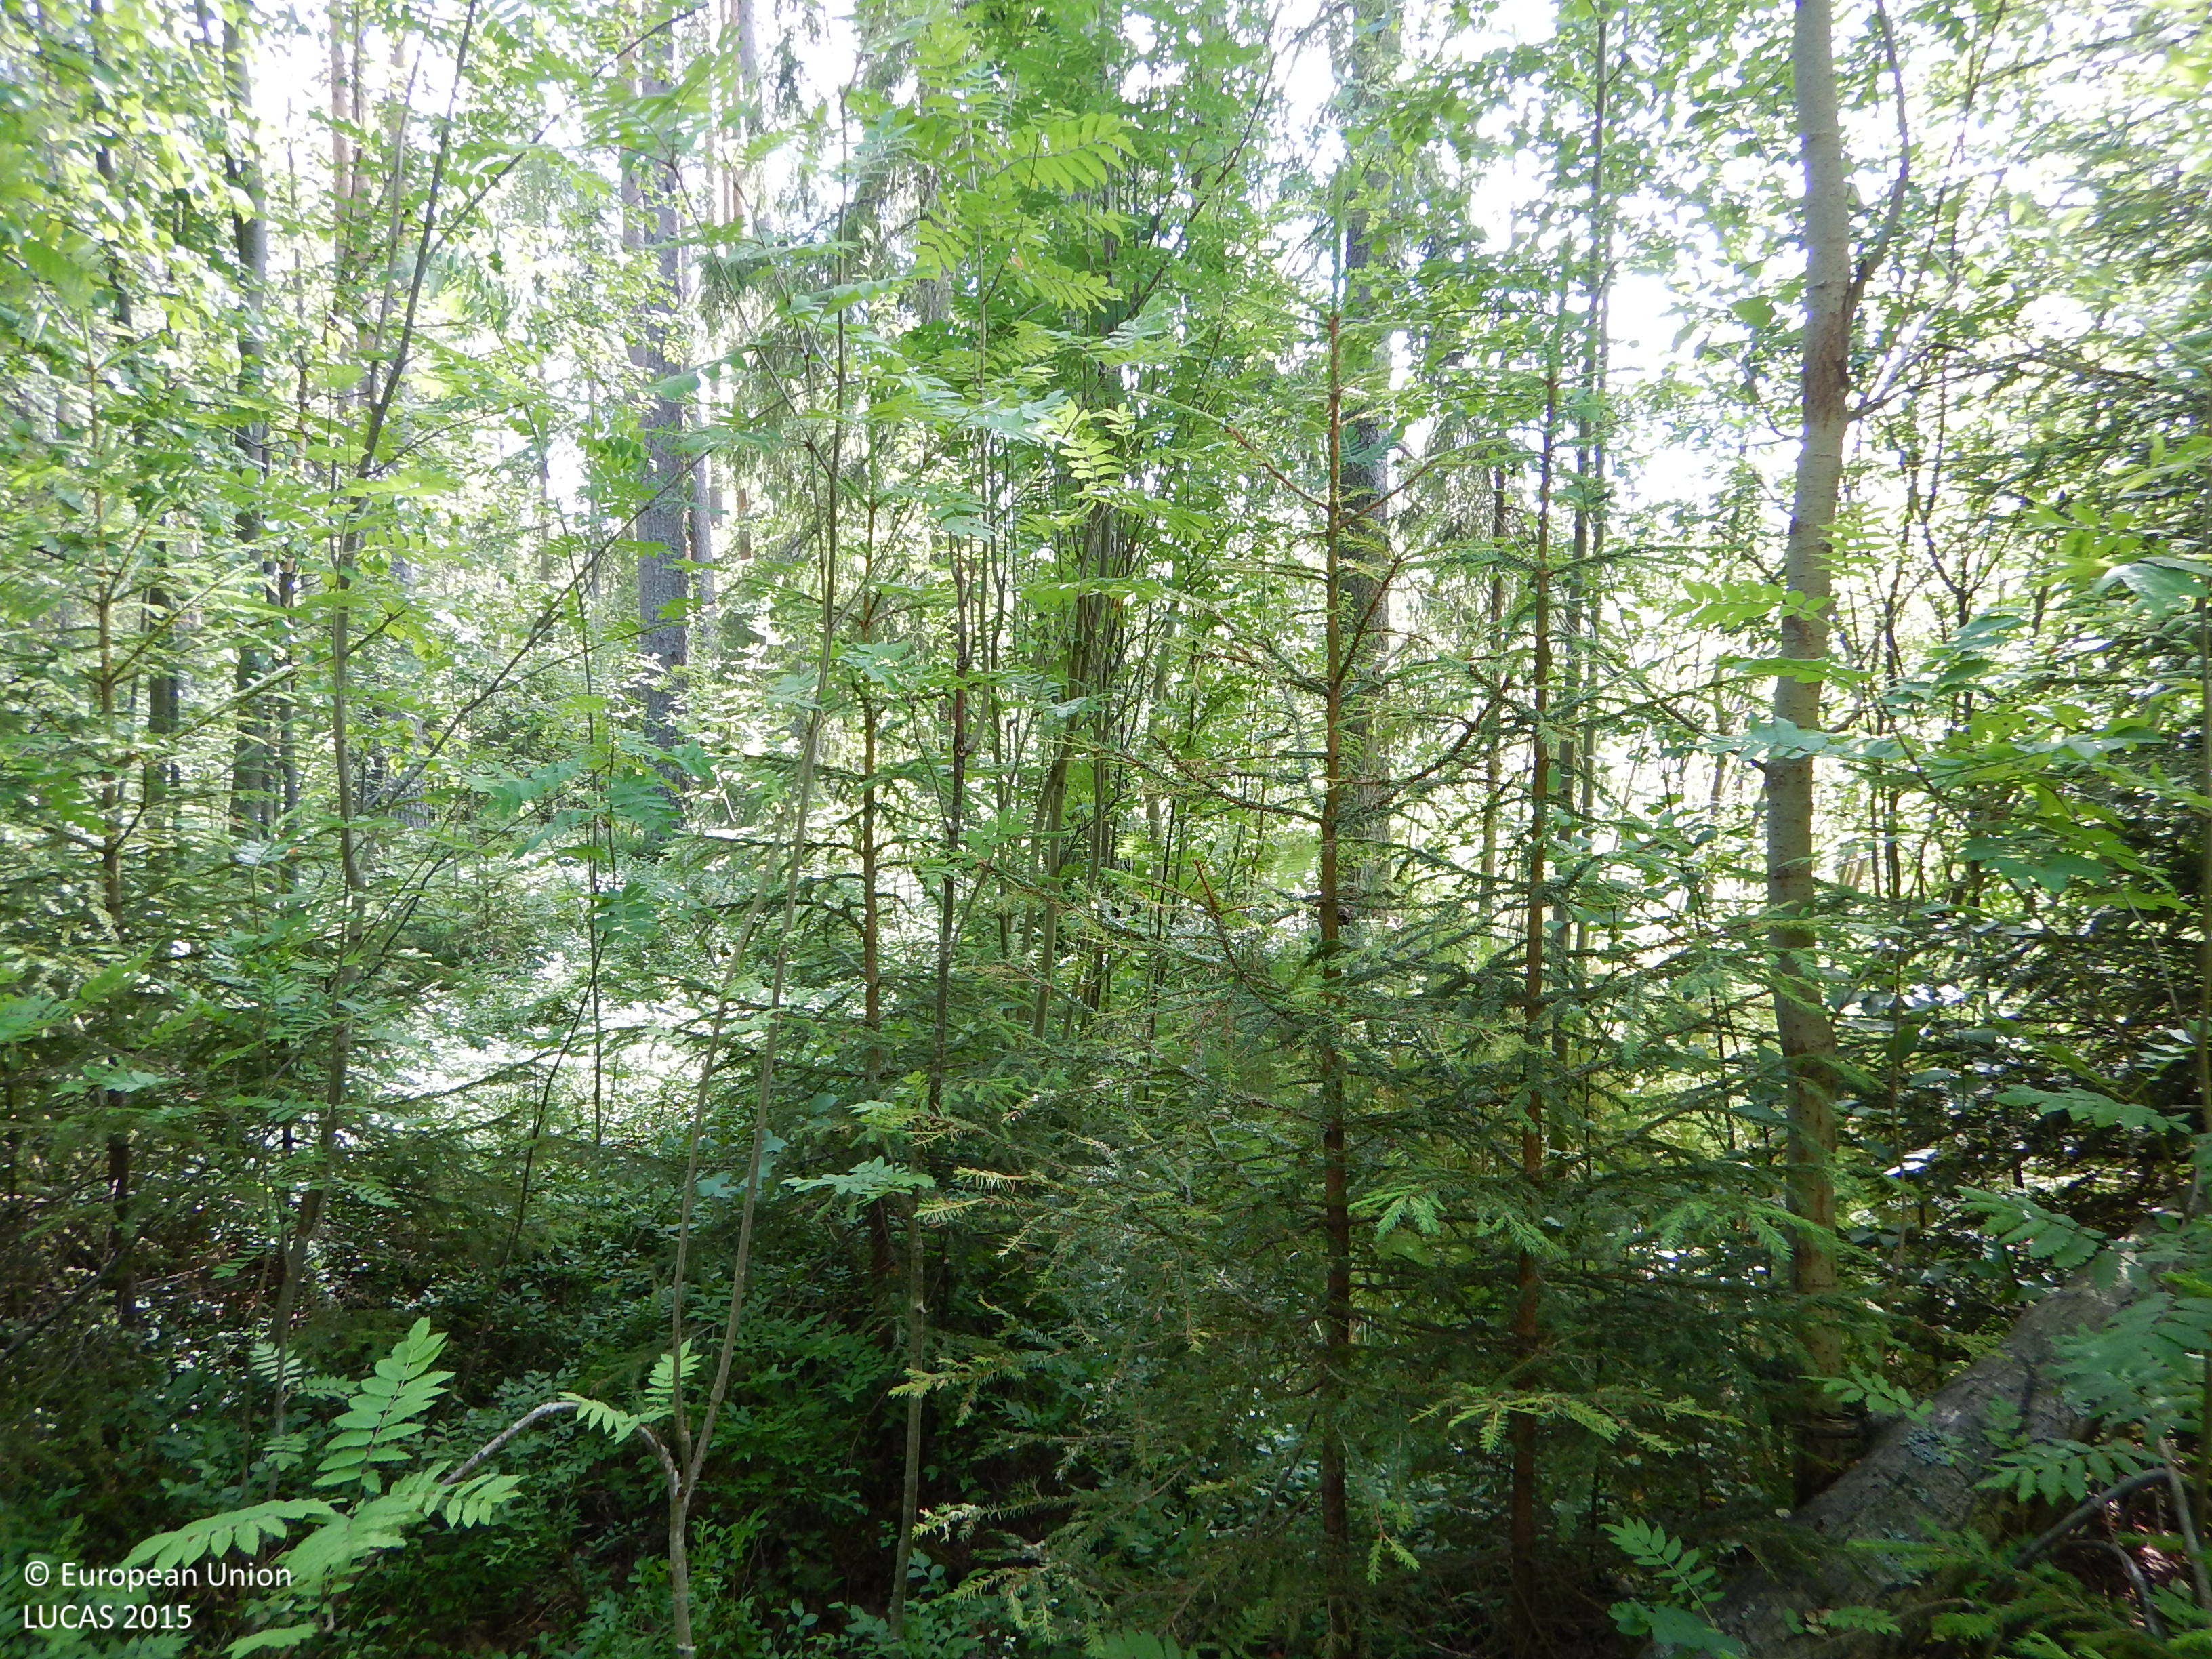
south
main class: Woodland
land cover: Spruce dominated mixed woodland
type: boreal forest
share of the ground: > 75 %
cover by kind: coniferous forest trees 45 %, broadleaved forest trees 30 %, shrubs 15 %, herbaceous plants 10 %
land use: Forestry
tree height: > 5 m
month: July
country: SE
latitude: 64.7808
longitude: 21.0213
